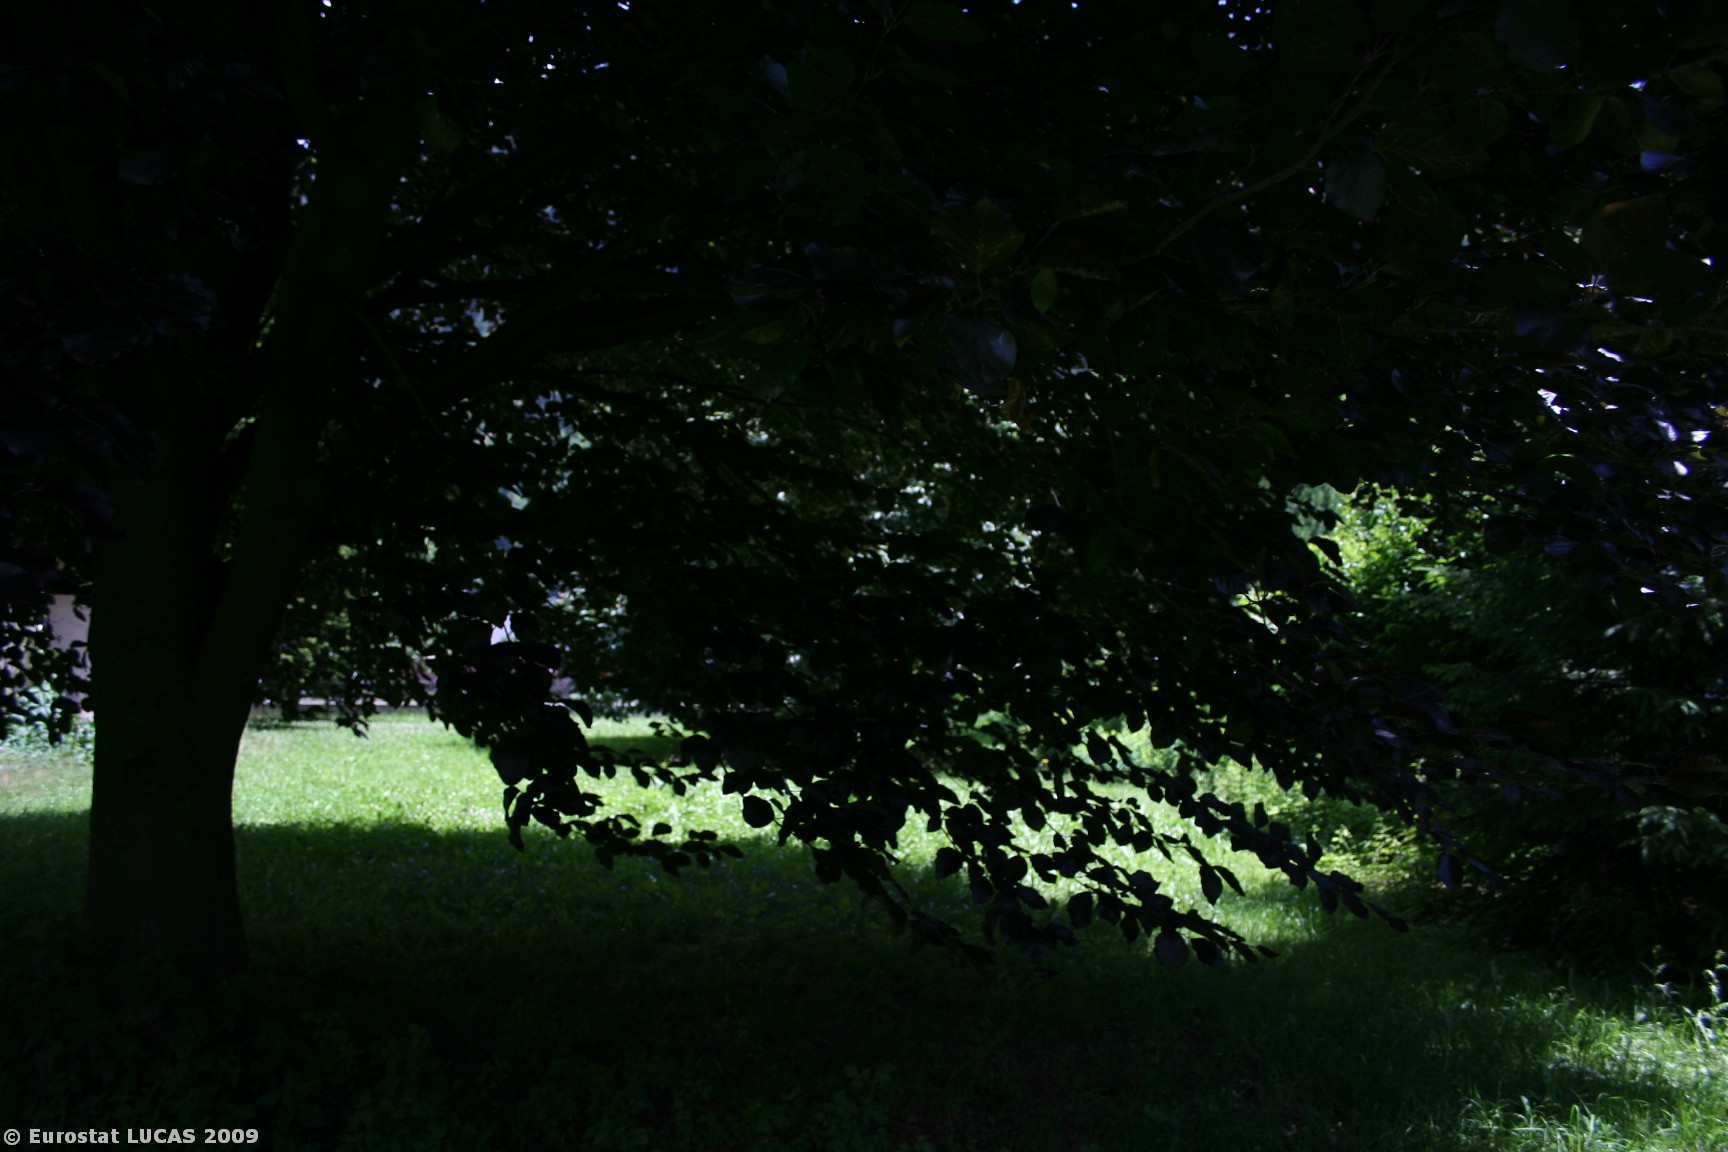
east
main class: Grassland
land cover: Grassland with sparse tree/shrub cover
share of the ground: > 75 %
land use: Agriculture (excluding fallow land and kitchen gardens)
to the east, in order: Grassland with sparse tree/shrub cover; Fences; Paved roads, cycling and walking lanes; Fences; Grassland without tree/shrub cover; Electric lines; Grassland without tree/shrub cover; Fences; Grass margins; Paved roads, cycling and walking lanes; Artificial constructions in urban areas; Inland running water; Shrubland with sparse tree cover; Fences; Paved roads, cycling and walking lanes; Shruby margins; Artificial constructions in urban areas; Grassland without tree/shrub cover; Fences; Grassland without tree/shrub cover
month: June
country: AT
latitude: 47.3256
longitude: 11.8641
